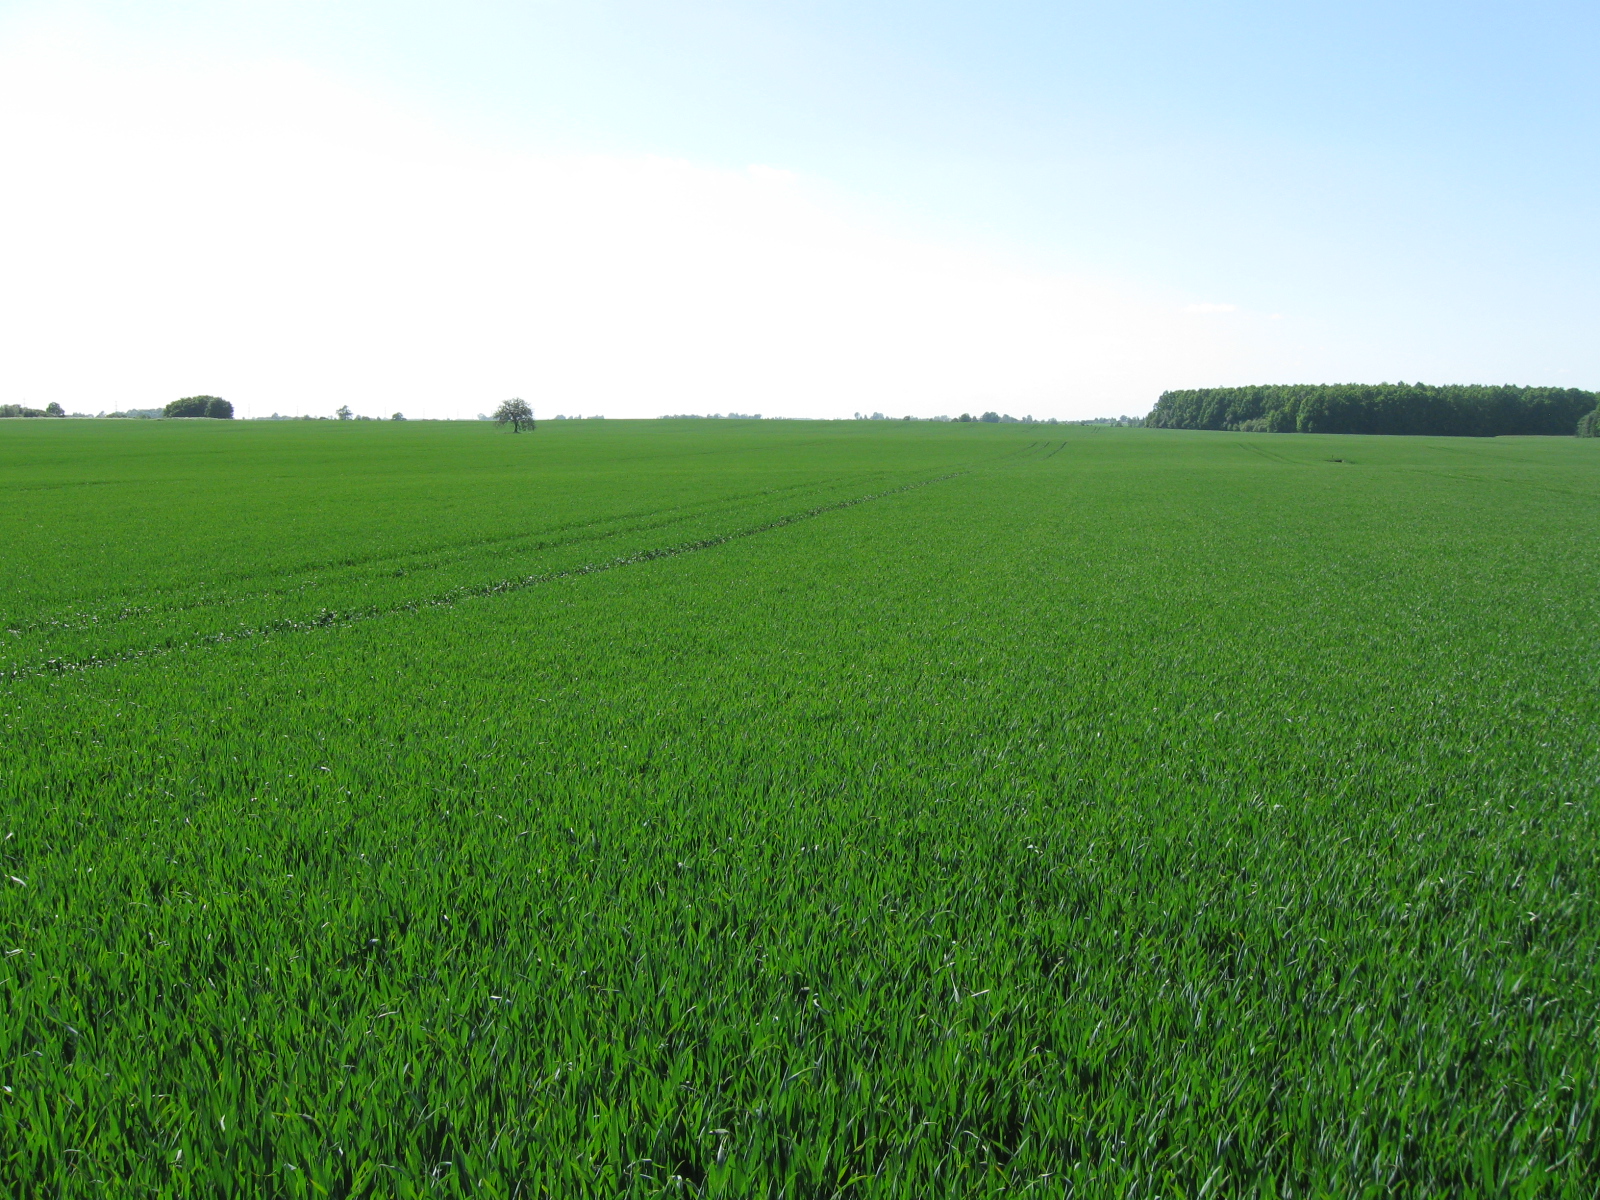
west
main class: Cropland
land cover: Common wheat
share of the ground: > 75 %
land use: Agriculture (excluding fallow land and kitchen gardens)
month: June
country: LT
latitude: 54.4225
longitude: 23.7264
